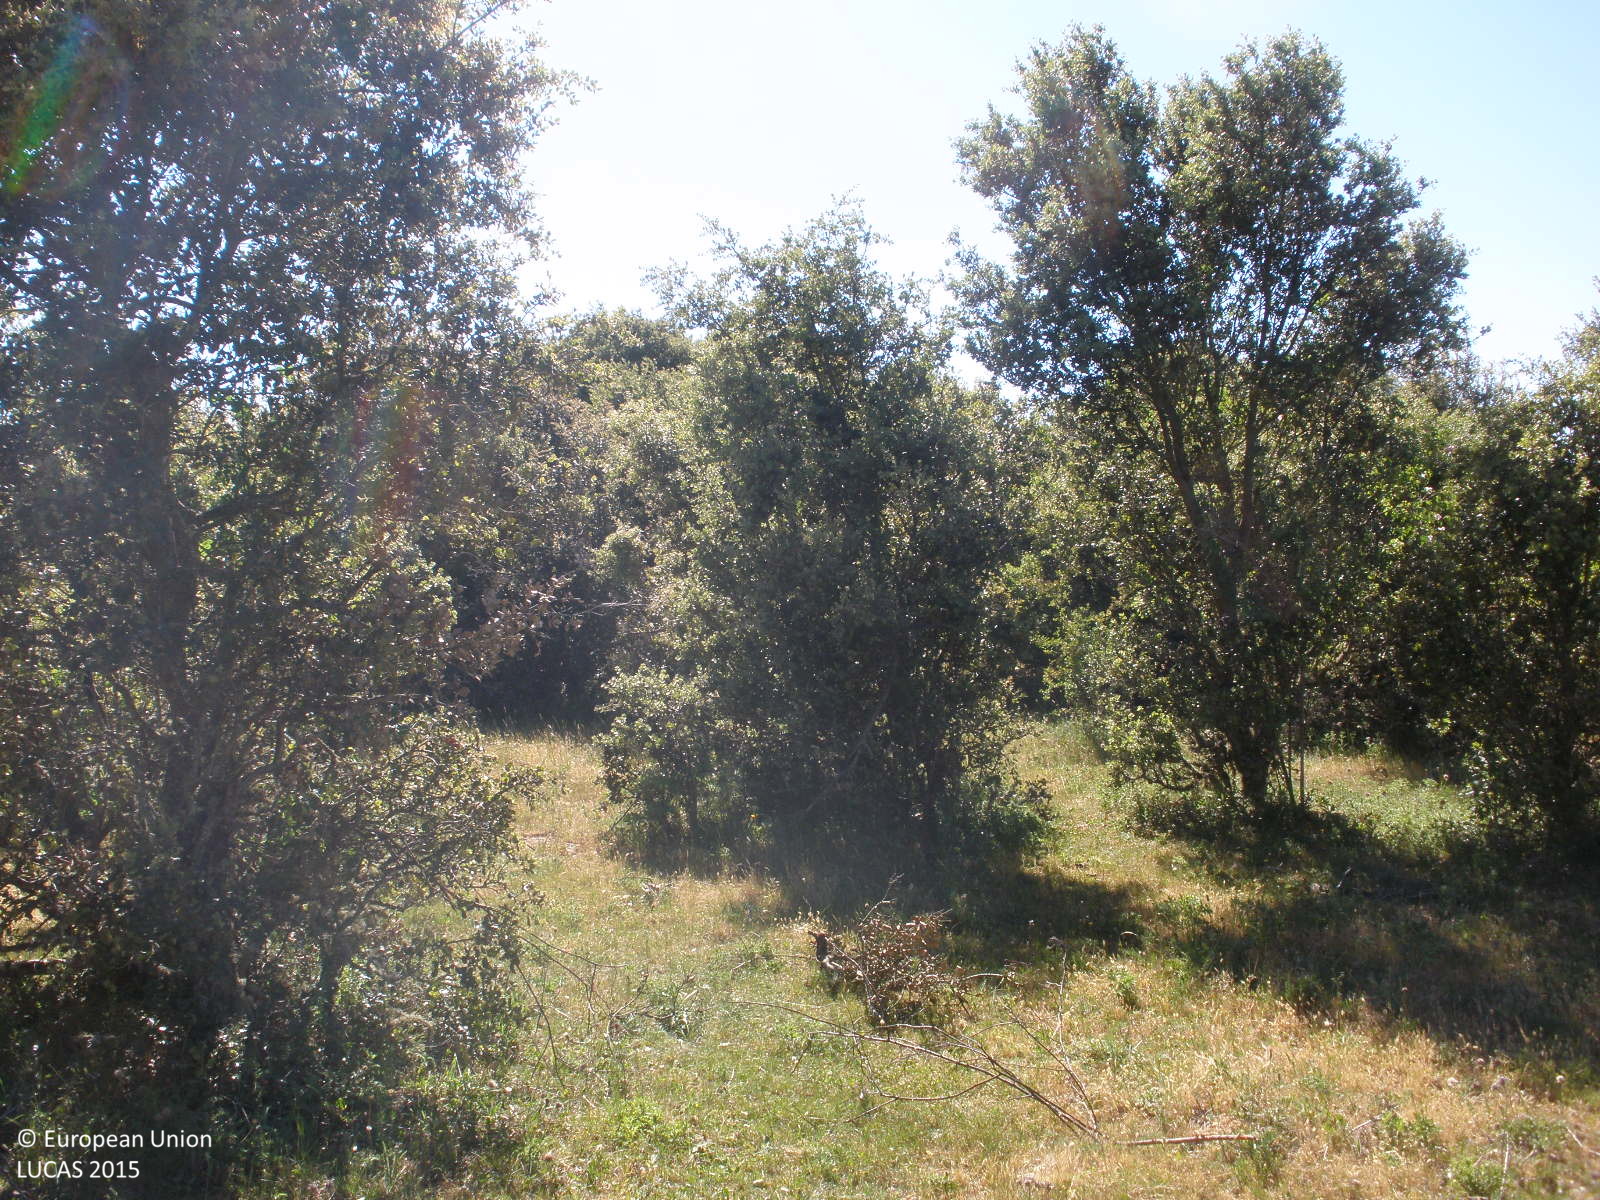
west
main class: Woodland
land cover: Broadleaved woodland
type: broadleaved evergreen forest
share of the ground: 25 - 50 %
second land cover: Grassland without tree/shrub cover
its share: > 75 %
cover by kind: herbaceous plants 50 %, broadleaved forest trees 30 %, shrubs 20 %
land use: Forestry
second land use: Agriculture (excluding fallow land and kitchen gardens)
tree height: < 5 m
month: May
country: ES
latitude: 40.7333
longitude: -5.8617
